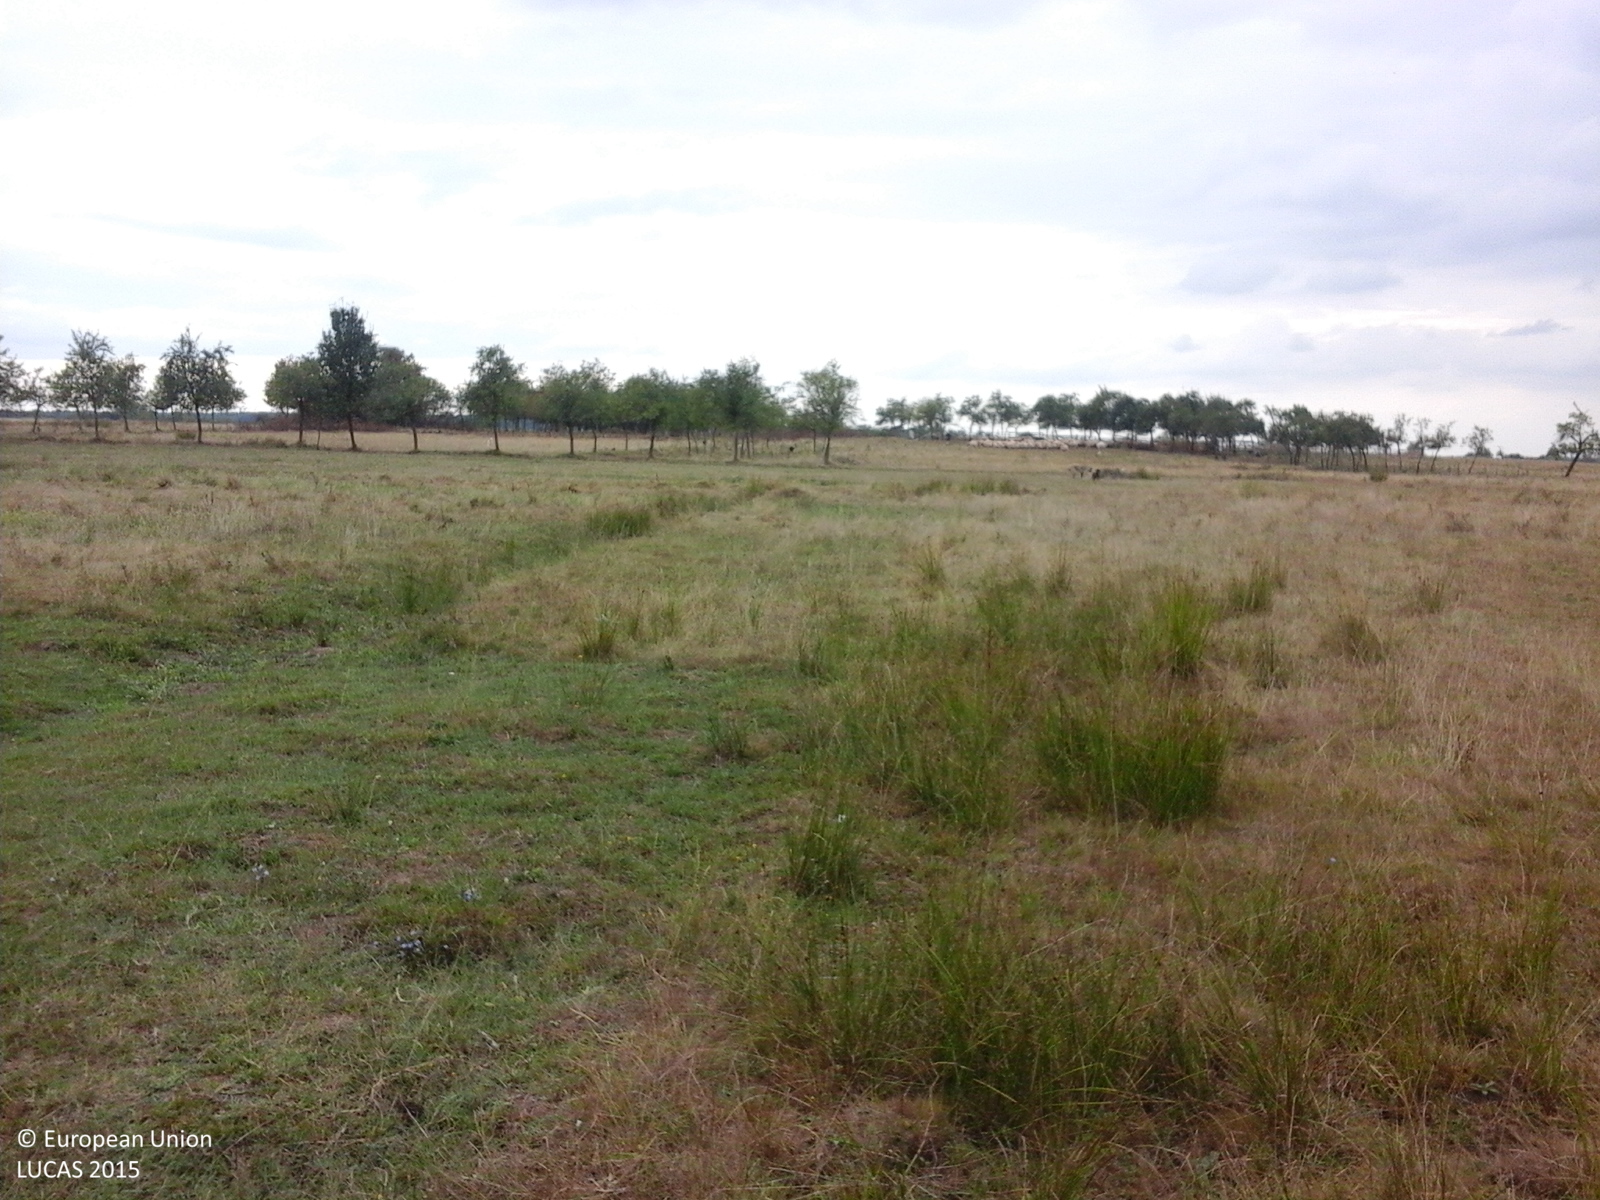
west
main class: Grassland
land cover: Grassland without tree/shrub cover
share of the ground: > 75 %
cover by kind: herbaceous plants 100 %
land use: Agriculture (excluding fallow land and kitchen gardens)
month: August
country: RO
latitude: 45.4865
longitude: 21.7163
